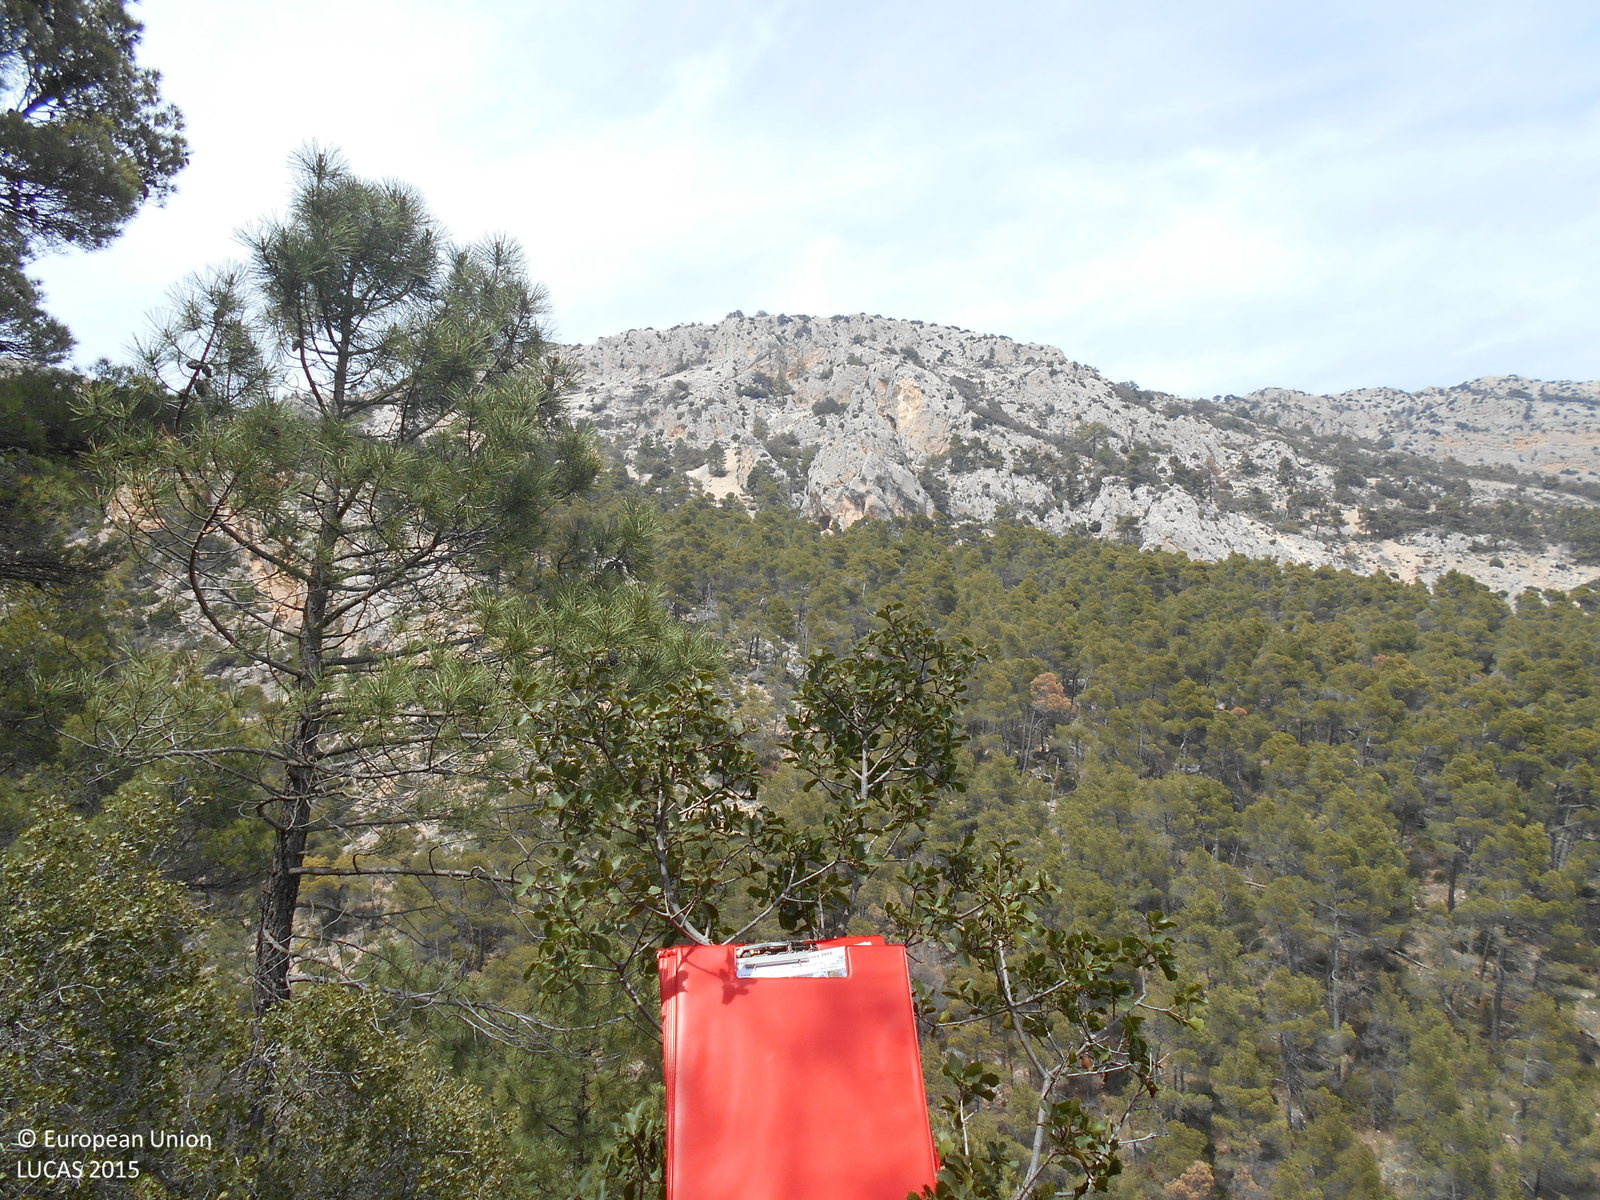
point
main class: Woodland
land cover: Pine dominated mixed woodland
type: coniferous forest of the mediterranean region
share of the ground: 50 - 75 %
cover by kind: coniferous forest trees 40 %, broadleaved forest trees 20 %, shrubs 20 %, consolidated bare surface 10 %, unconsolidated bare surface 10 %
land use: Amenities, museums, leisure
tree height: > 5 m
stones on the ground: 25 - 50 %
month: April
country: ES
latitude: 37.8654
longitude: -1.5448
